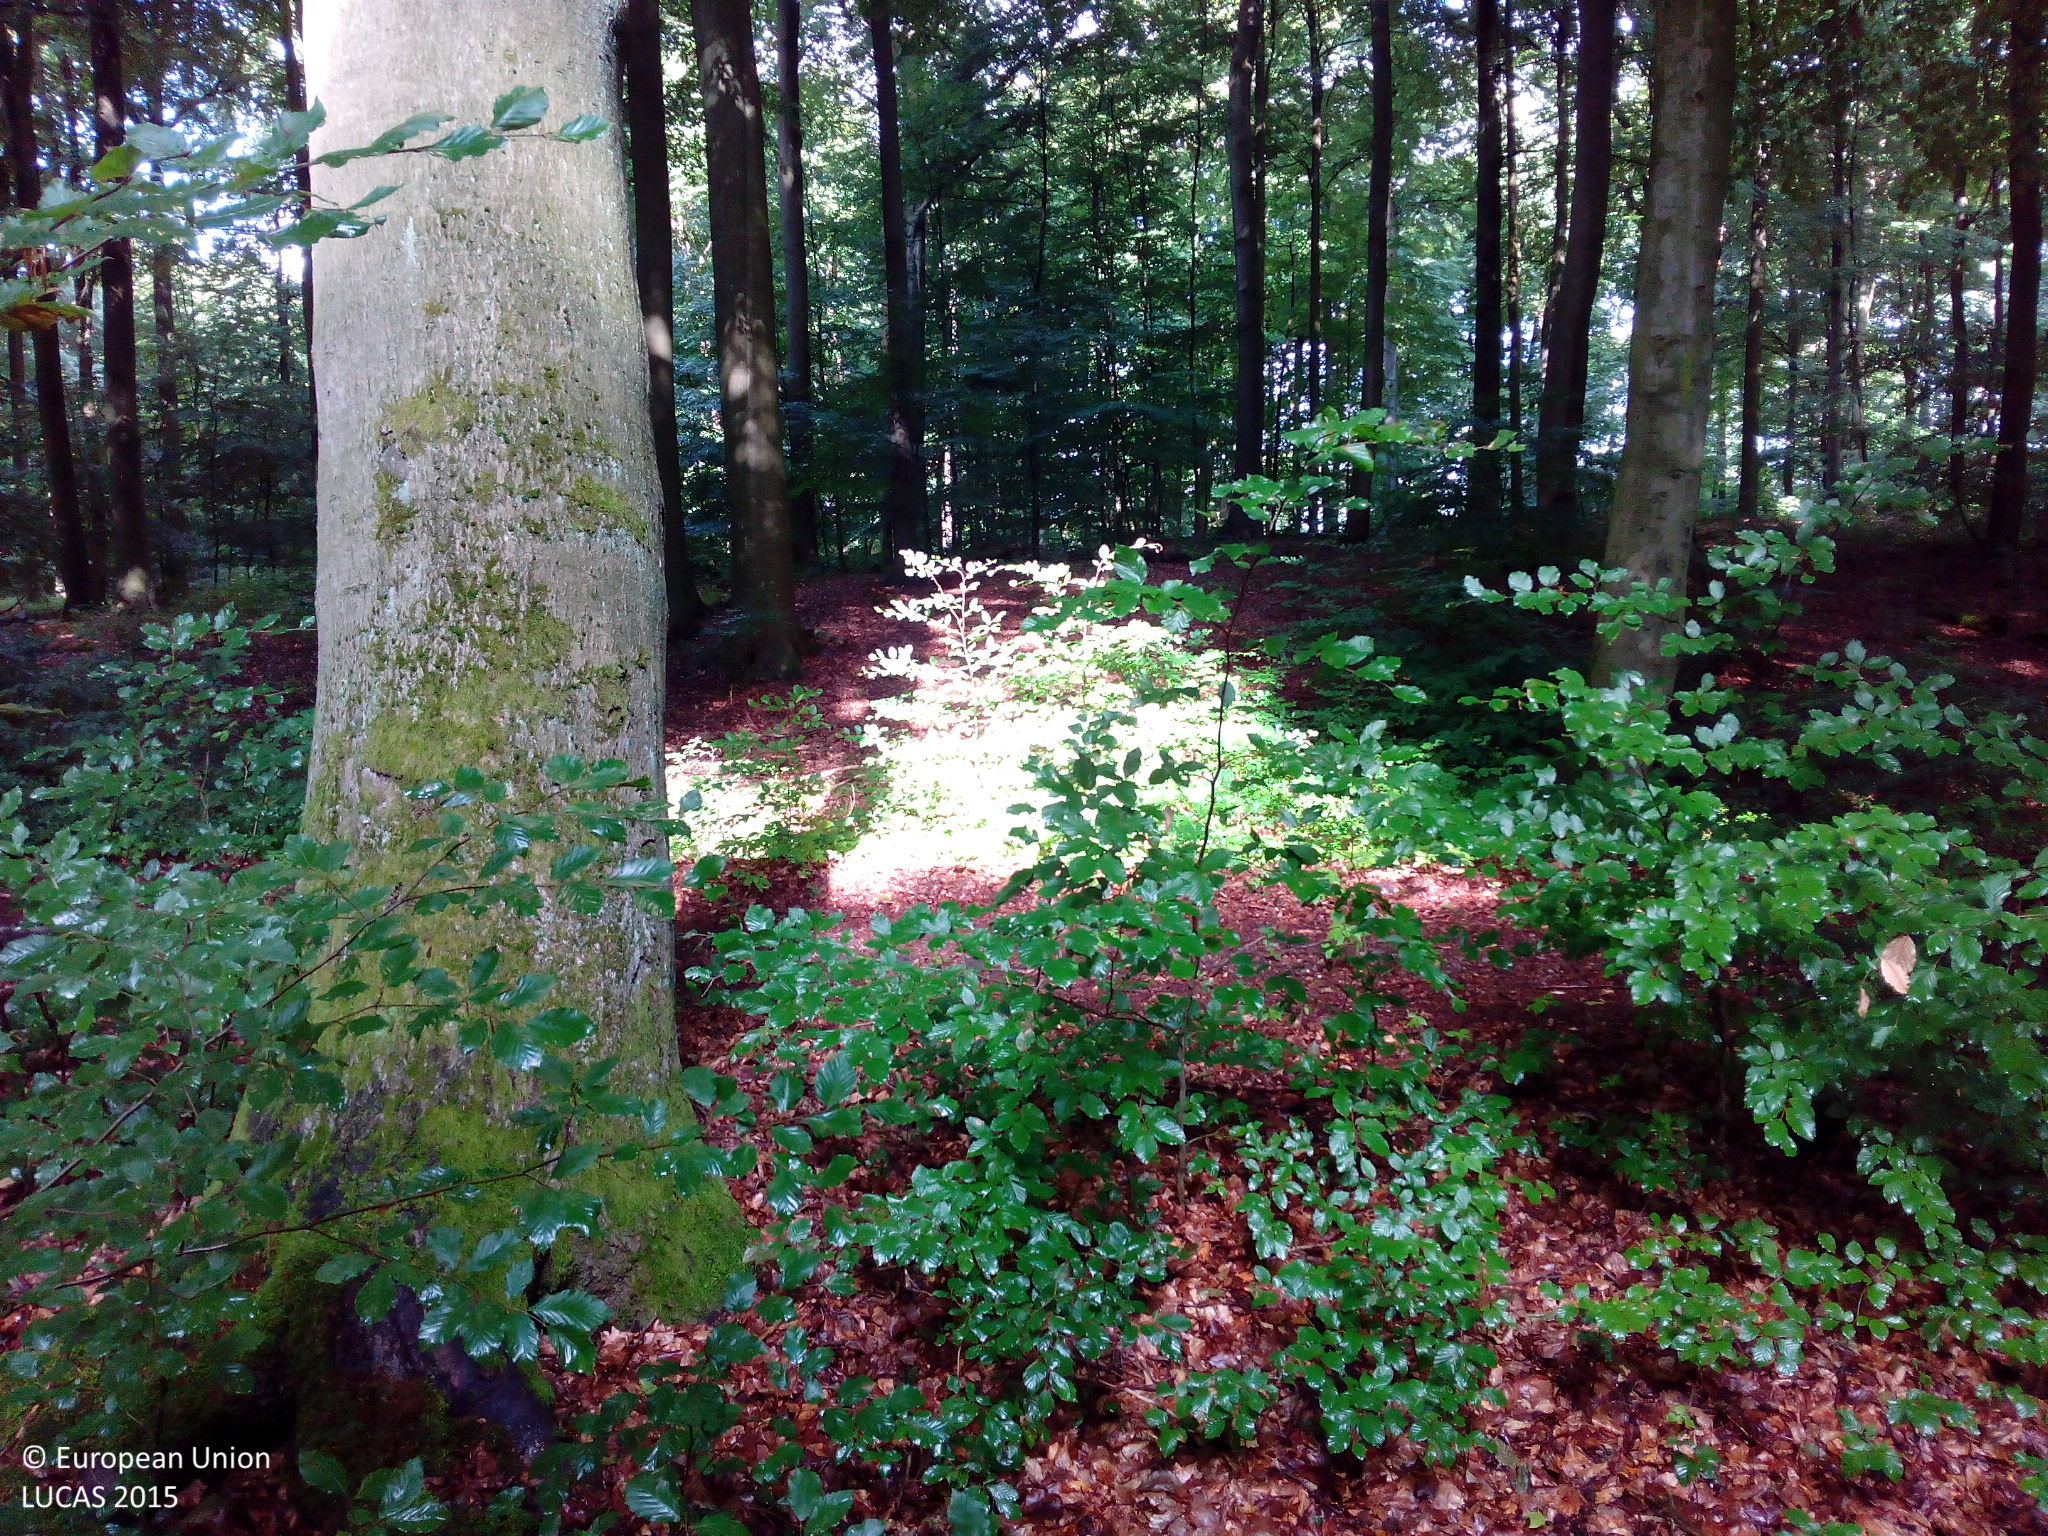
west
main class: Woodland
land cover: Broadleaved woodland
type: beech forest
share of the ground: > 75 %
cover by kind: broadleaved forest trees 90 %, unconsolidated bare surface 10 %
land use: Forestry
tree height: > 5 m
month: July
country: DE
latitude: 52.7744
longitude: 13.5429
